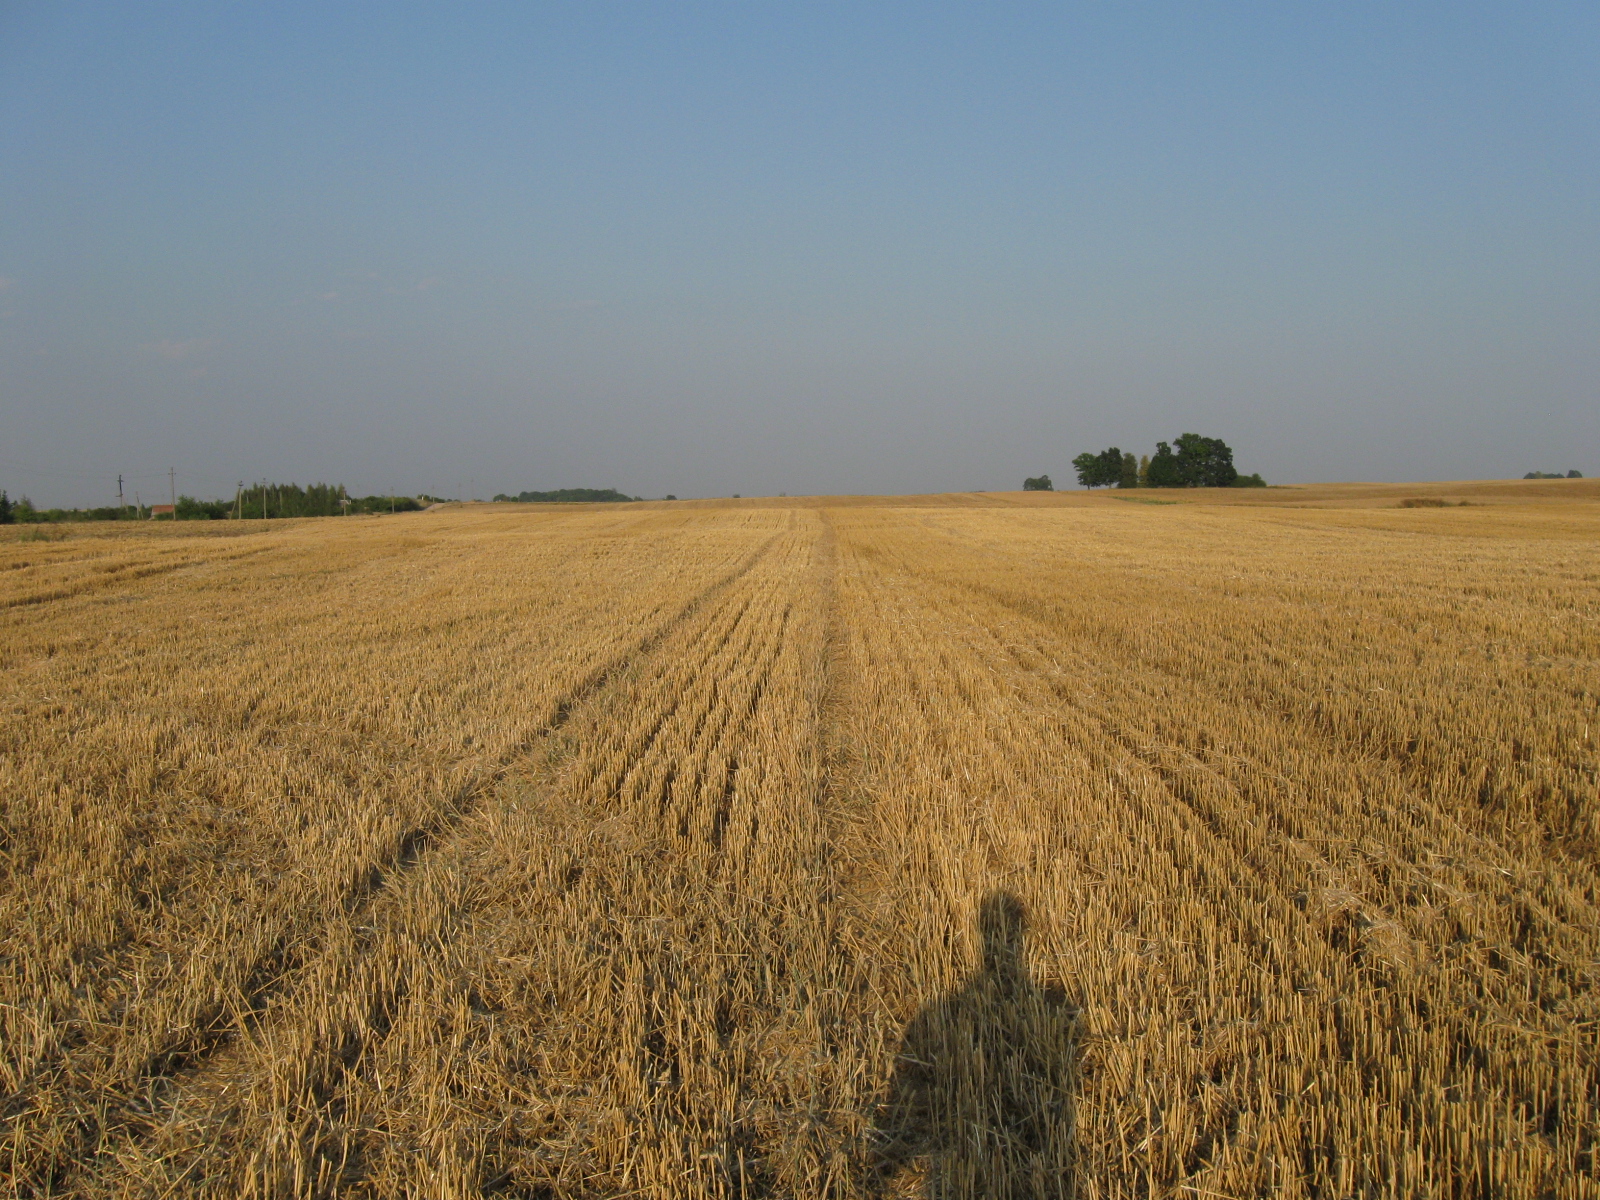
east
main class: Cropland
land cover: Common wheat
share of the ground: < 10 %
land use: Agriculture (excluding fallow land and kitchen gardens)
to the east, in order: Common wheat
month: August
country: LT
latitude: 54.4727
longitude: 23.2711
